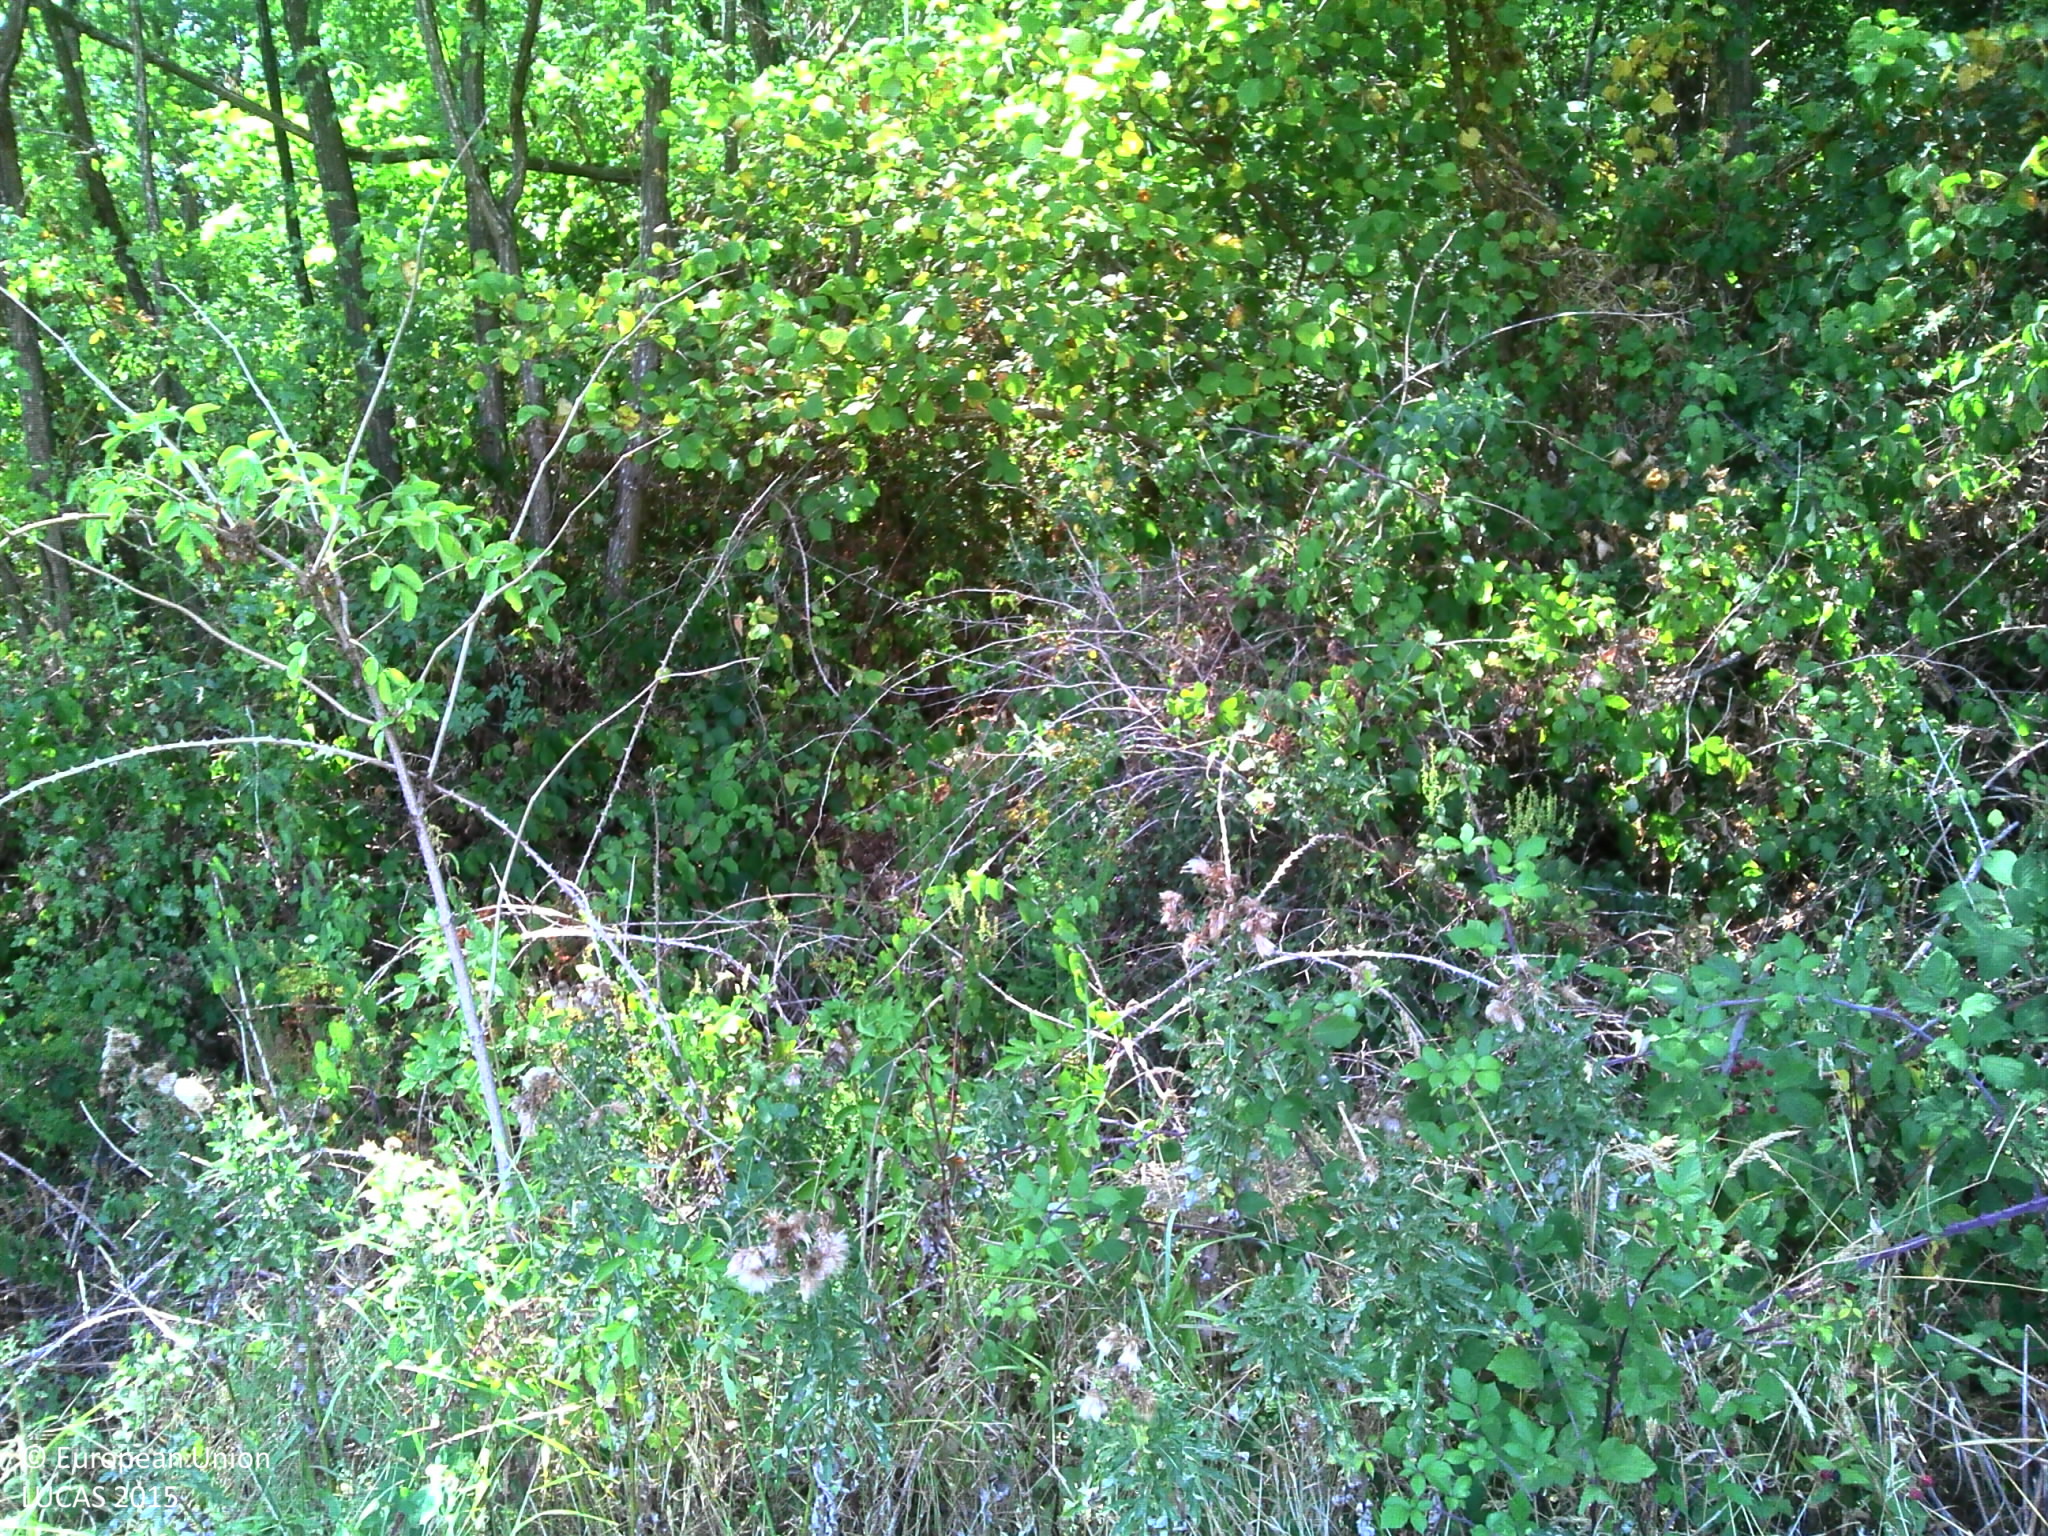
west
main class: Woodland
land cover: Broadleaved woodland
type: mesophytic deciduous forest
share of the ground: > 75 %
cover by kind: broadleaved forest trees 95 %, herbaceous plants 5 %
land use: Forestry
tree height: > 5 m
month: July
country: FR
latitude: 45.4368
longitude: 4.9295
